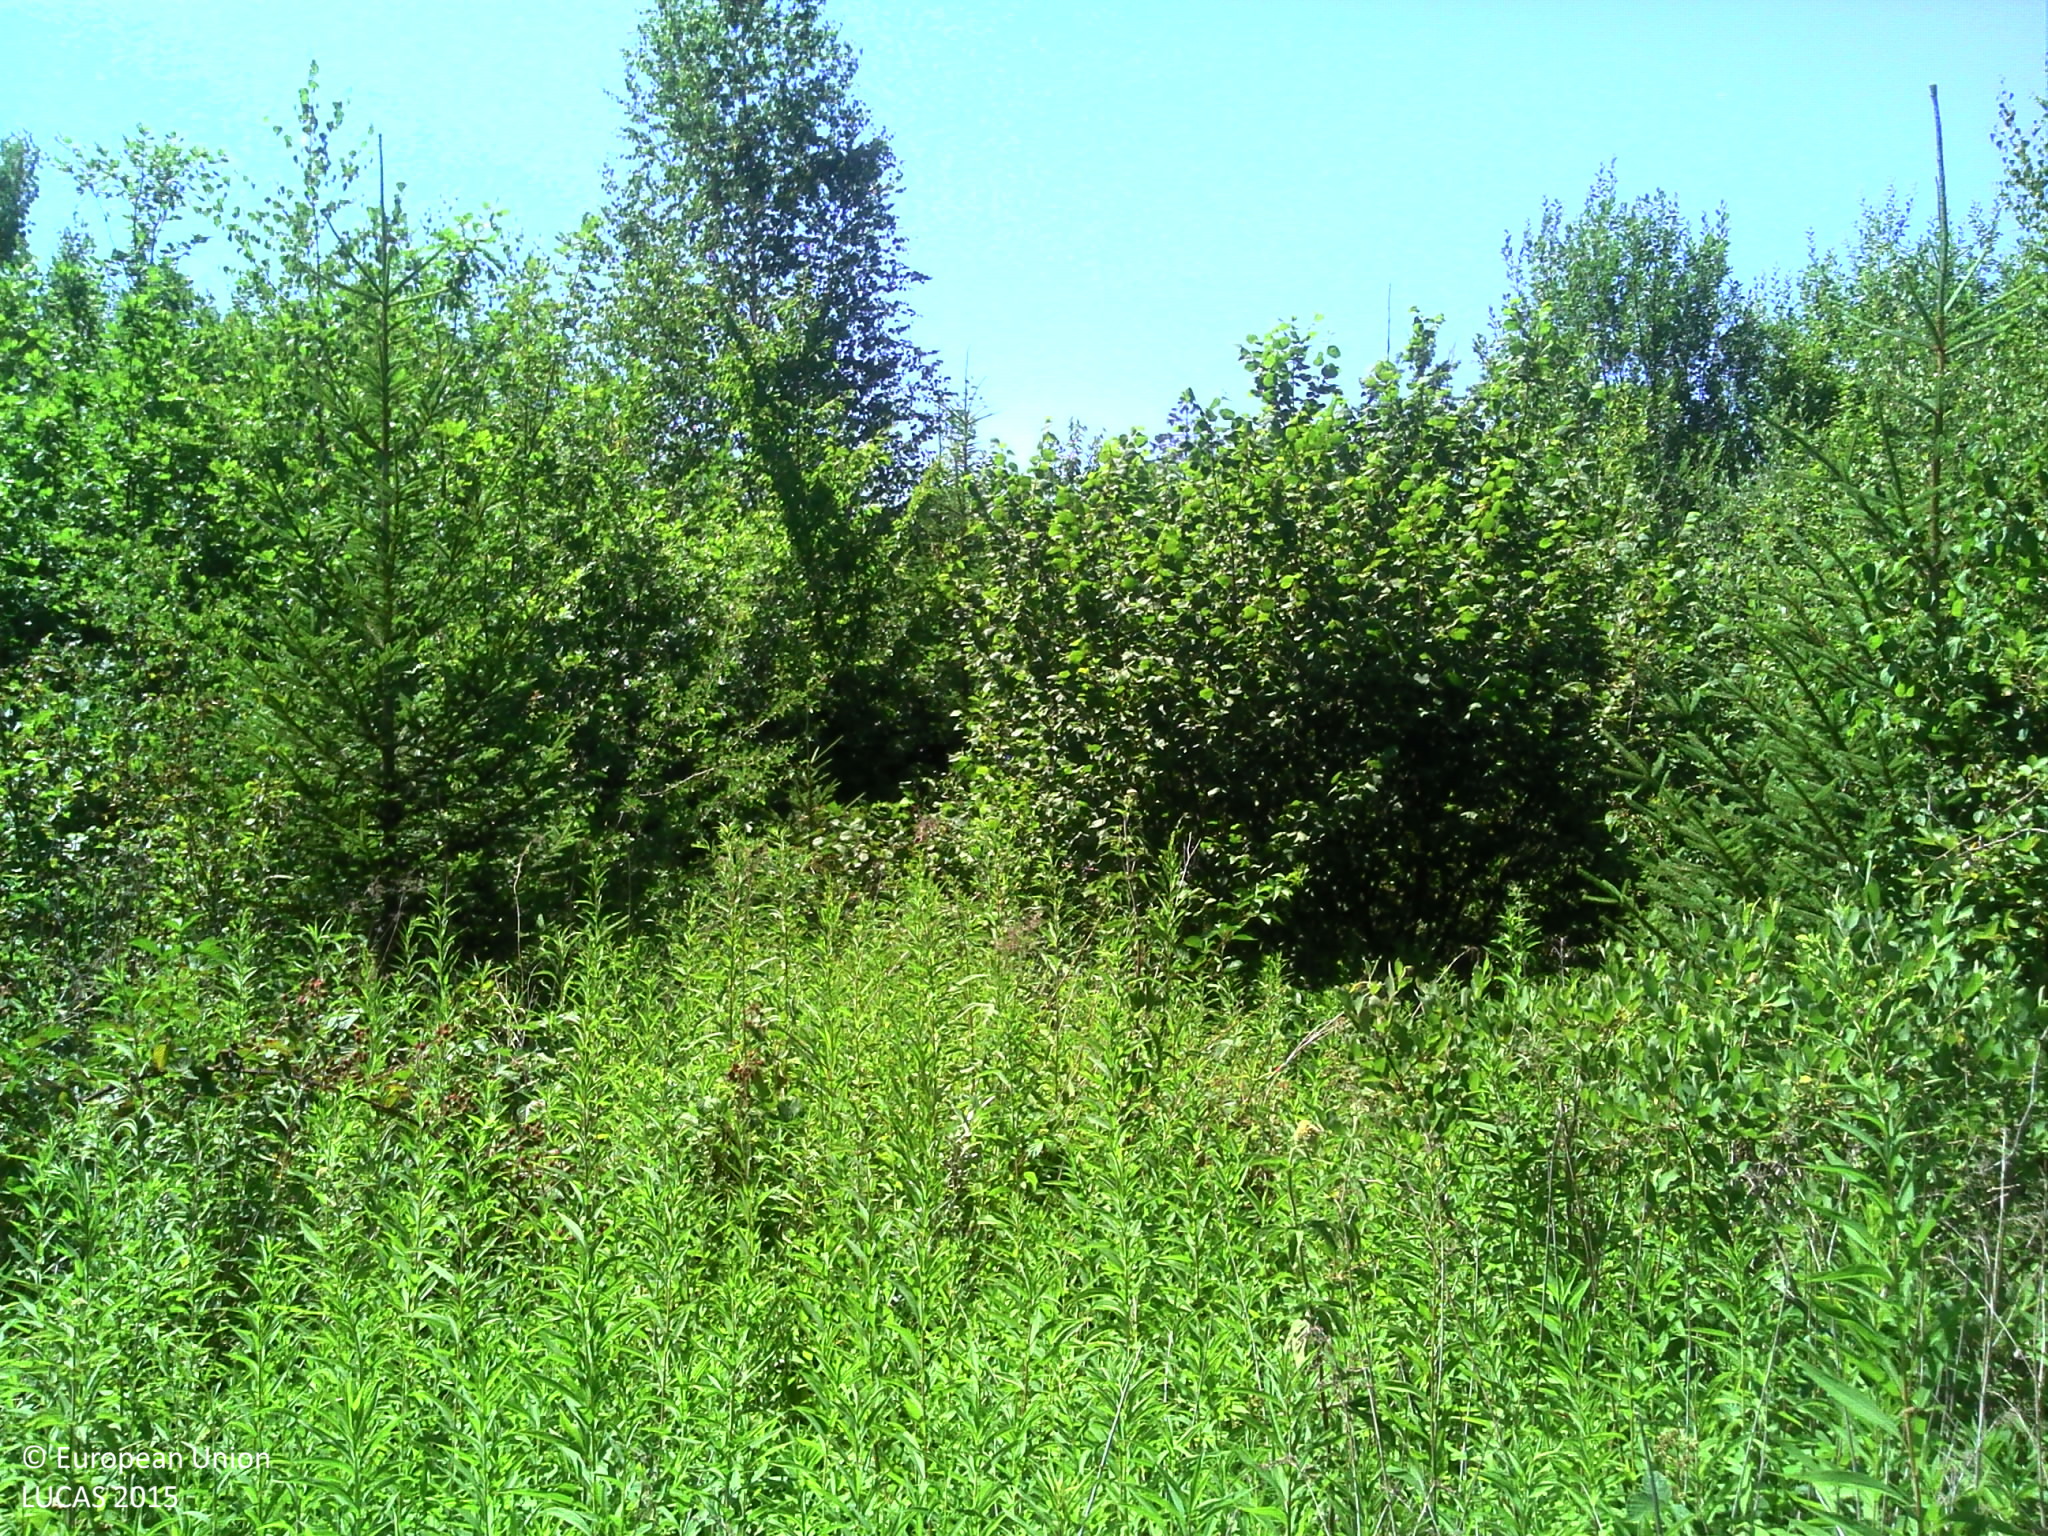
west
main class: Shrubland
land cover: Shrubland with sparse tree cover
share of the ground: > 75 %
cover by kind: shrubs 60 %, herbaceous plants 35 %, broadleaved forest trees 5 %
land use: Abandoned areas
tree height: < 5 m
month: July
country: FR
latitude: 46.3089
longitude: 6.4065
